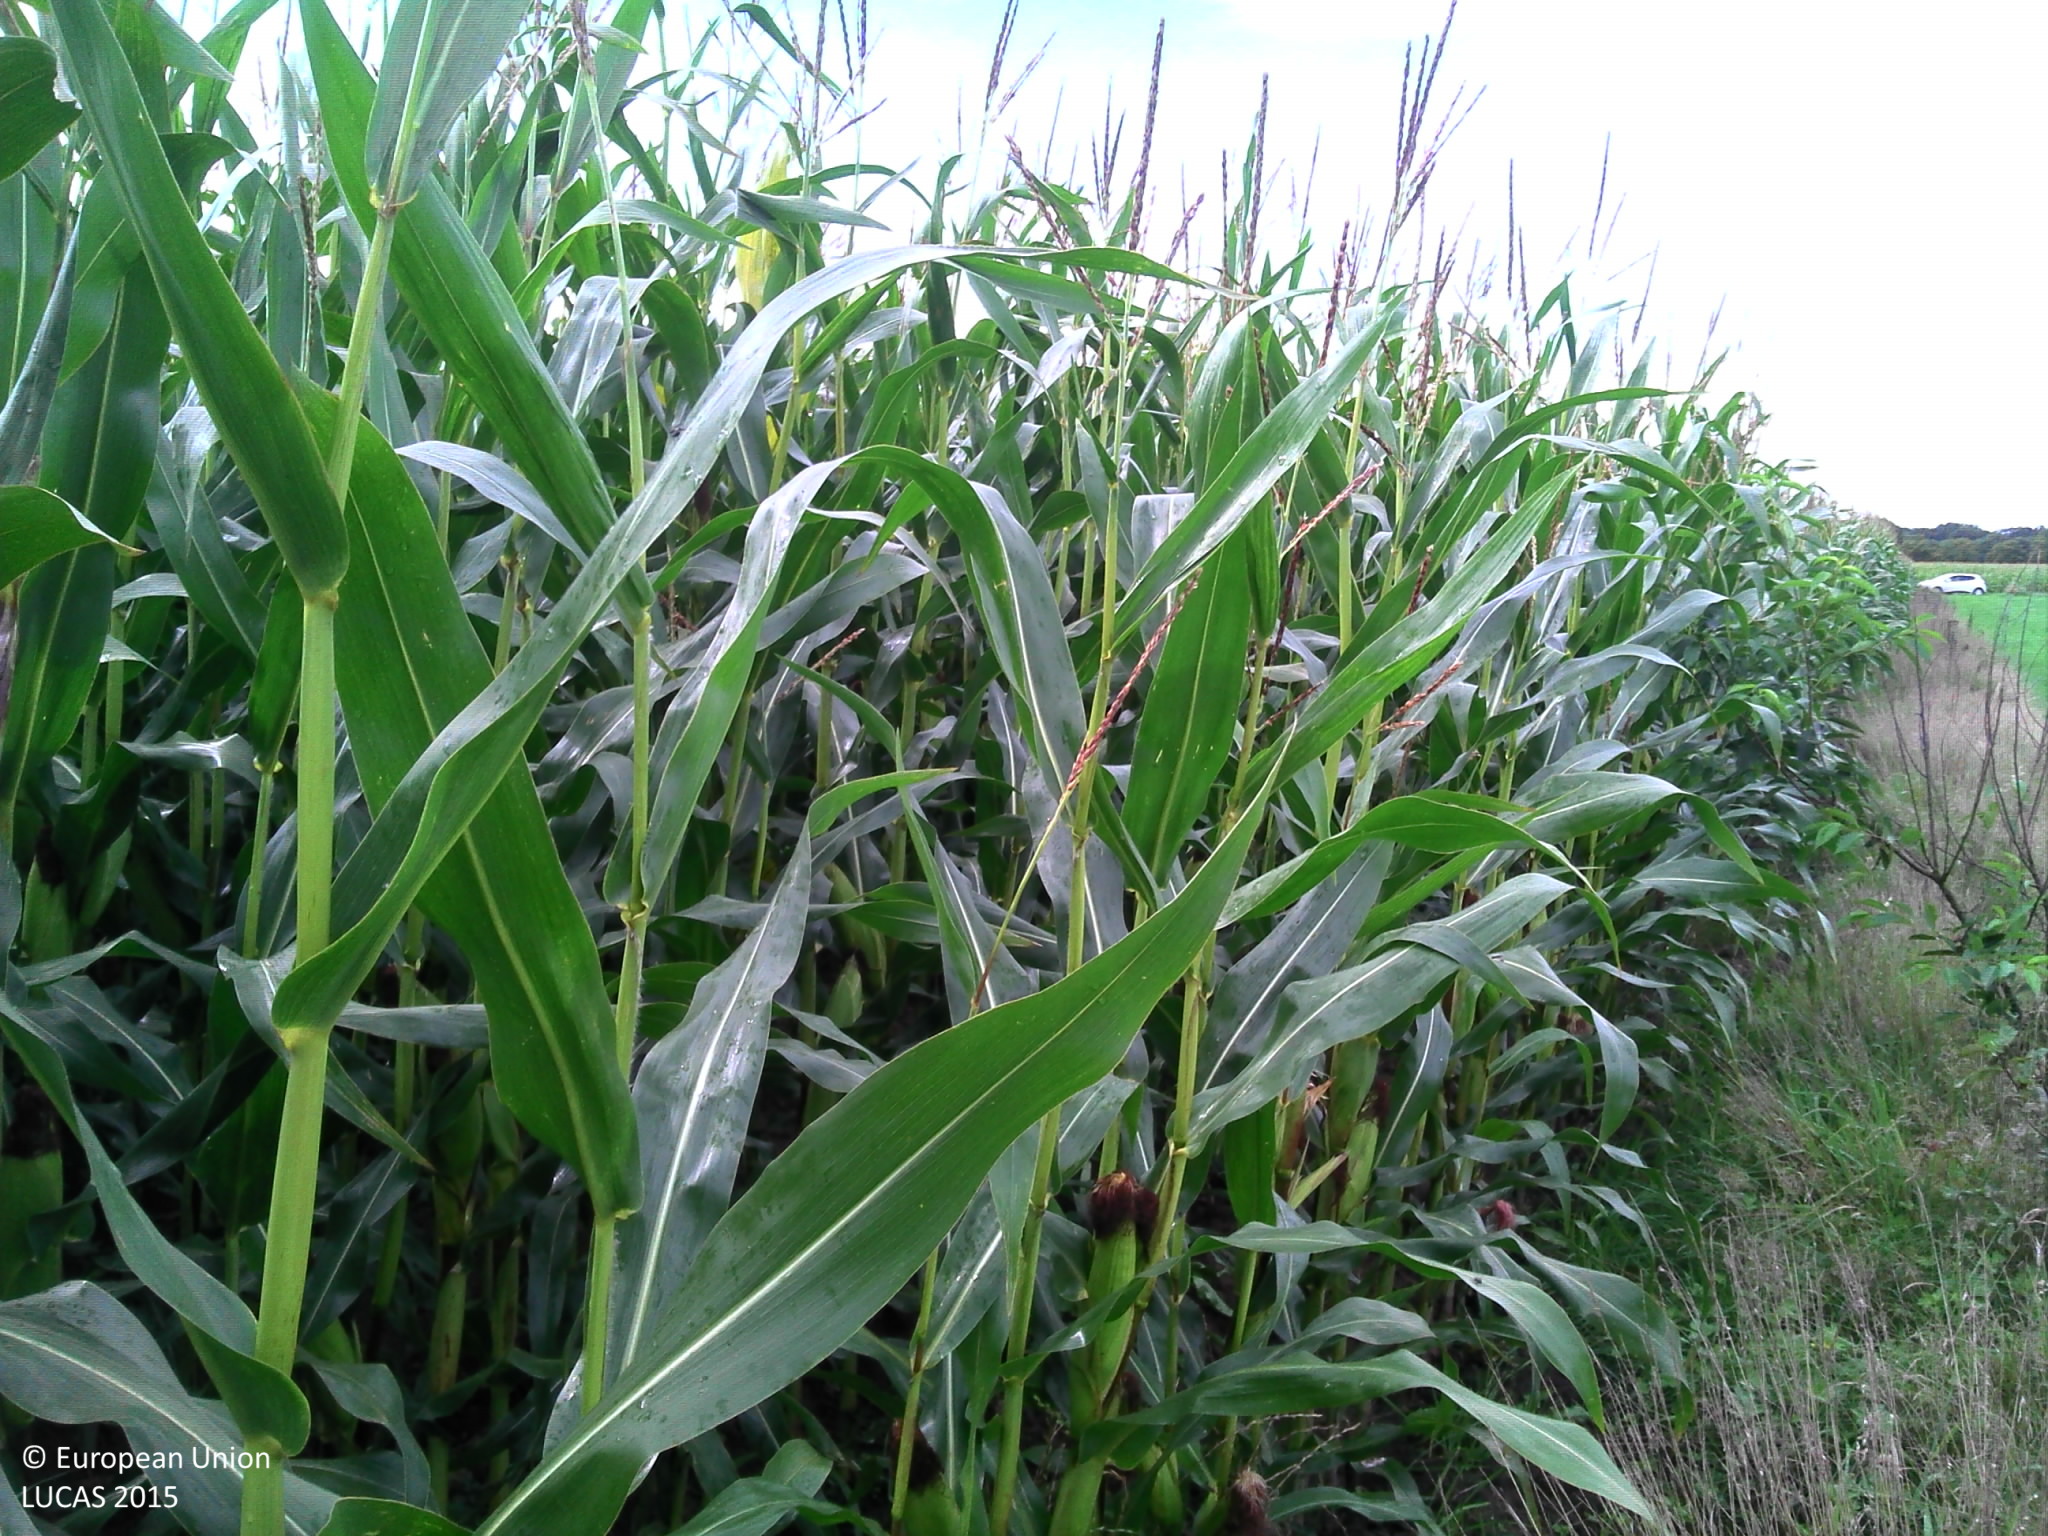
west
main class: Cropland
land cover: Maize
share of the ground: > 75 %
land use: Agriculture (excluding fallow land and kitchen gardens)
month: September
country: BE
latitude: 51.3198
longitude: 4.6441
